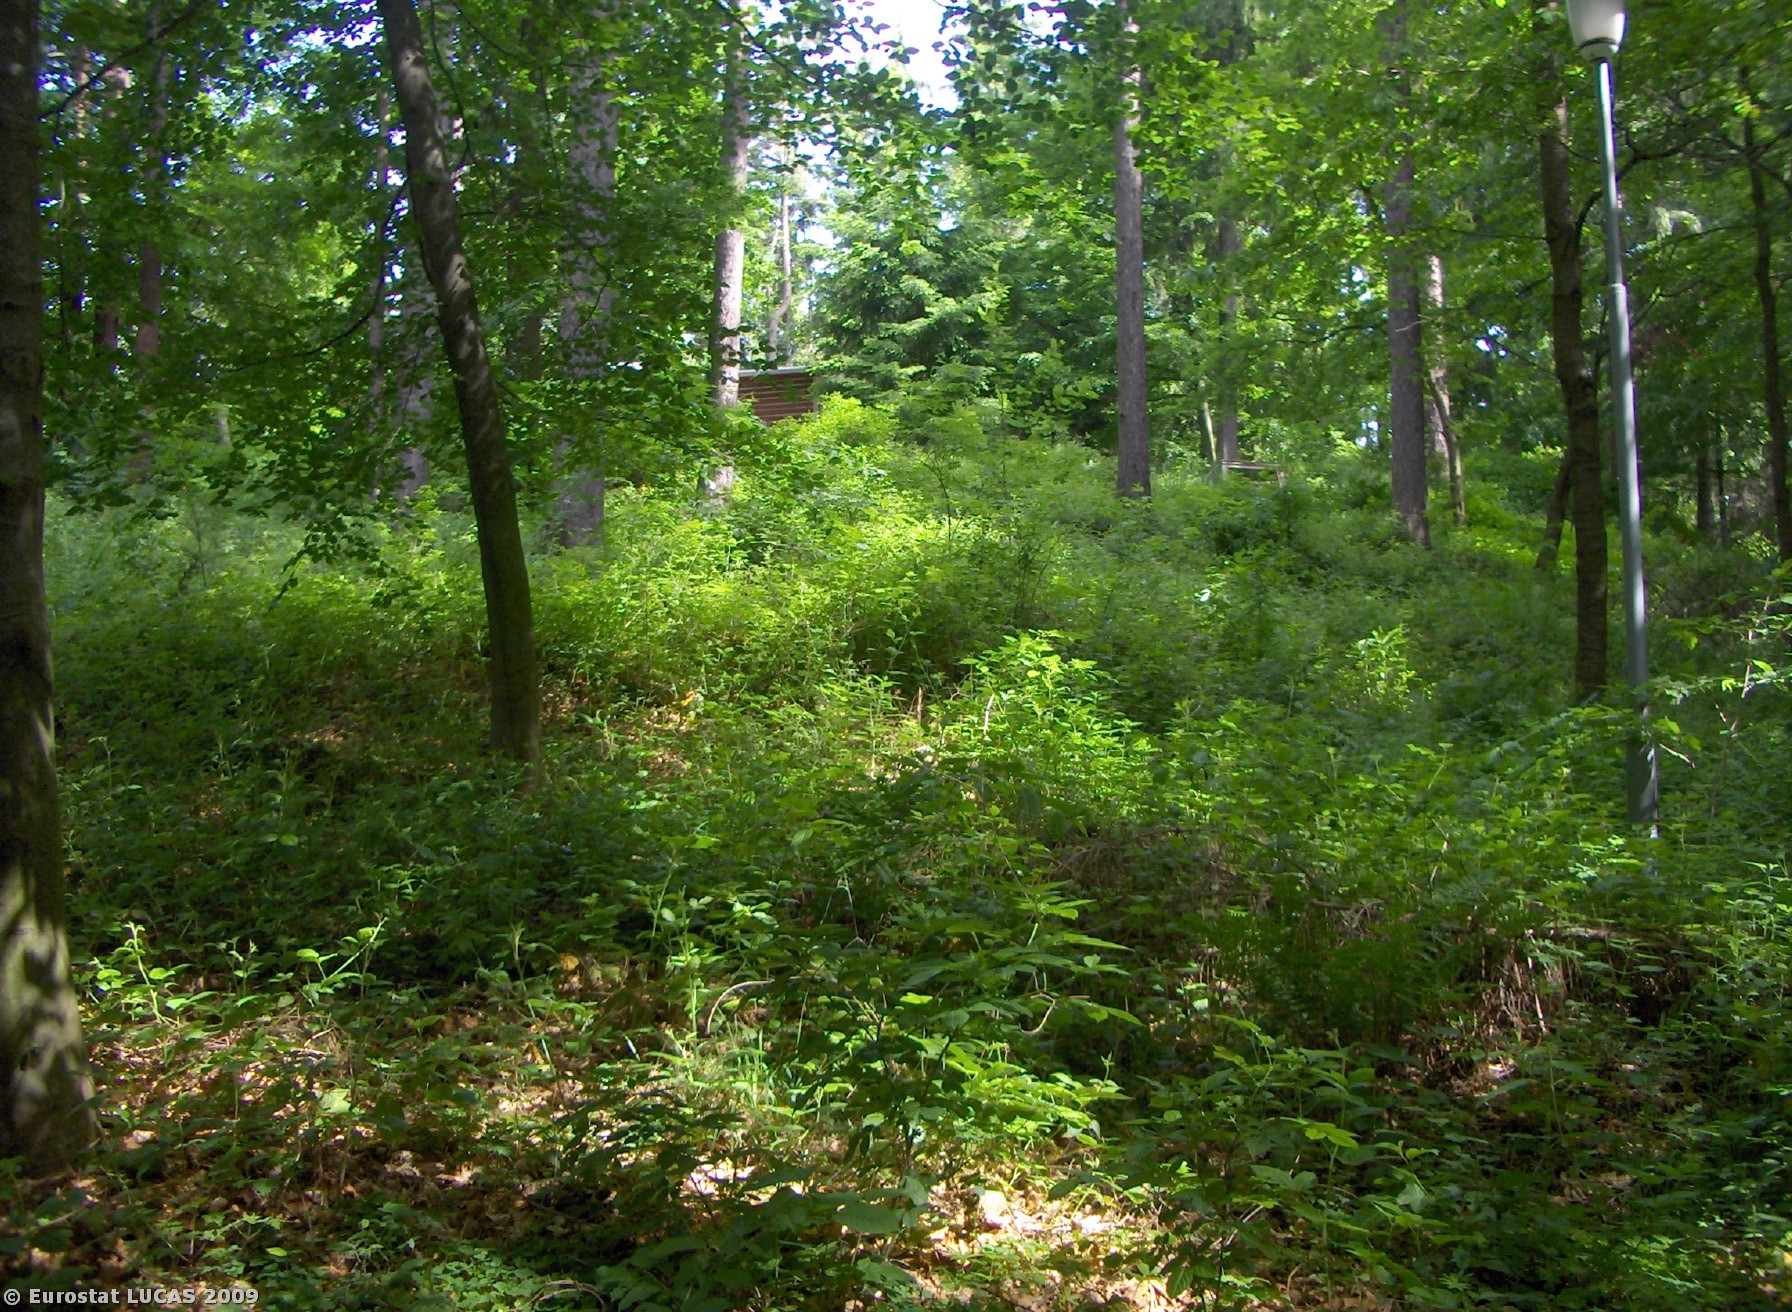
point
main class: Woodland
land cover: Mixed woodland
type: hemiboreal forest and nemoral coniferous forest and mixed broadleaved-coniferous forest
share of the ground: > 75 %
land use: Community services
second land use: Forestry
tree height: > 5 m
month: May
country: CZ
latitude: 49.3147
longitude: 14.1964
